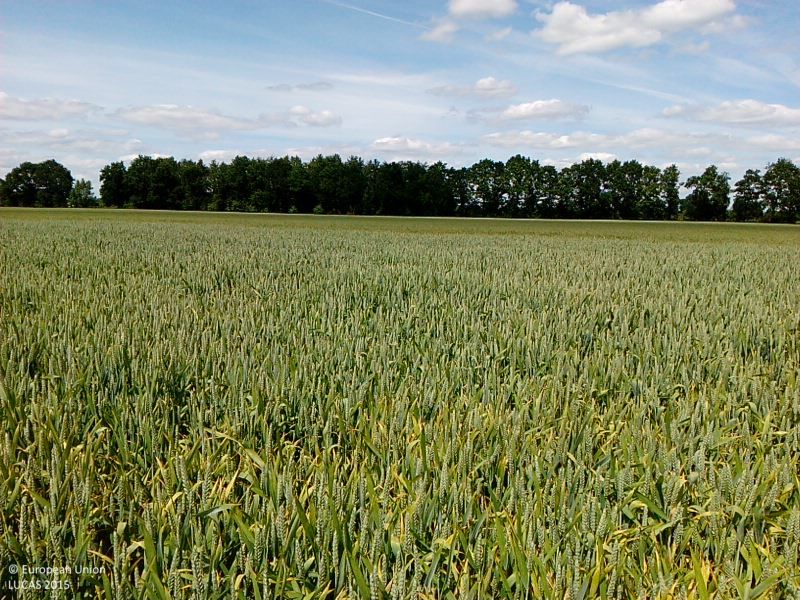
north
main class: Cropland
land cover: Common wheat
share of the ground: > 75 %
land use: Agriculture (excluding fallow land and kitchen gardens)
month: June
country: DE
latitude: 52.5473
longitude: 7.4197
